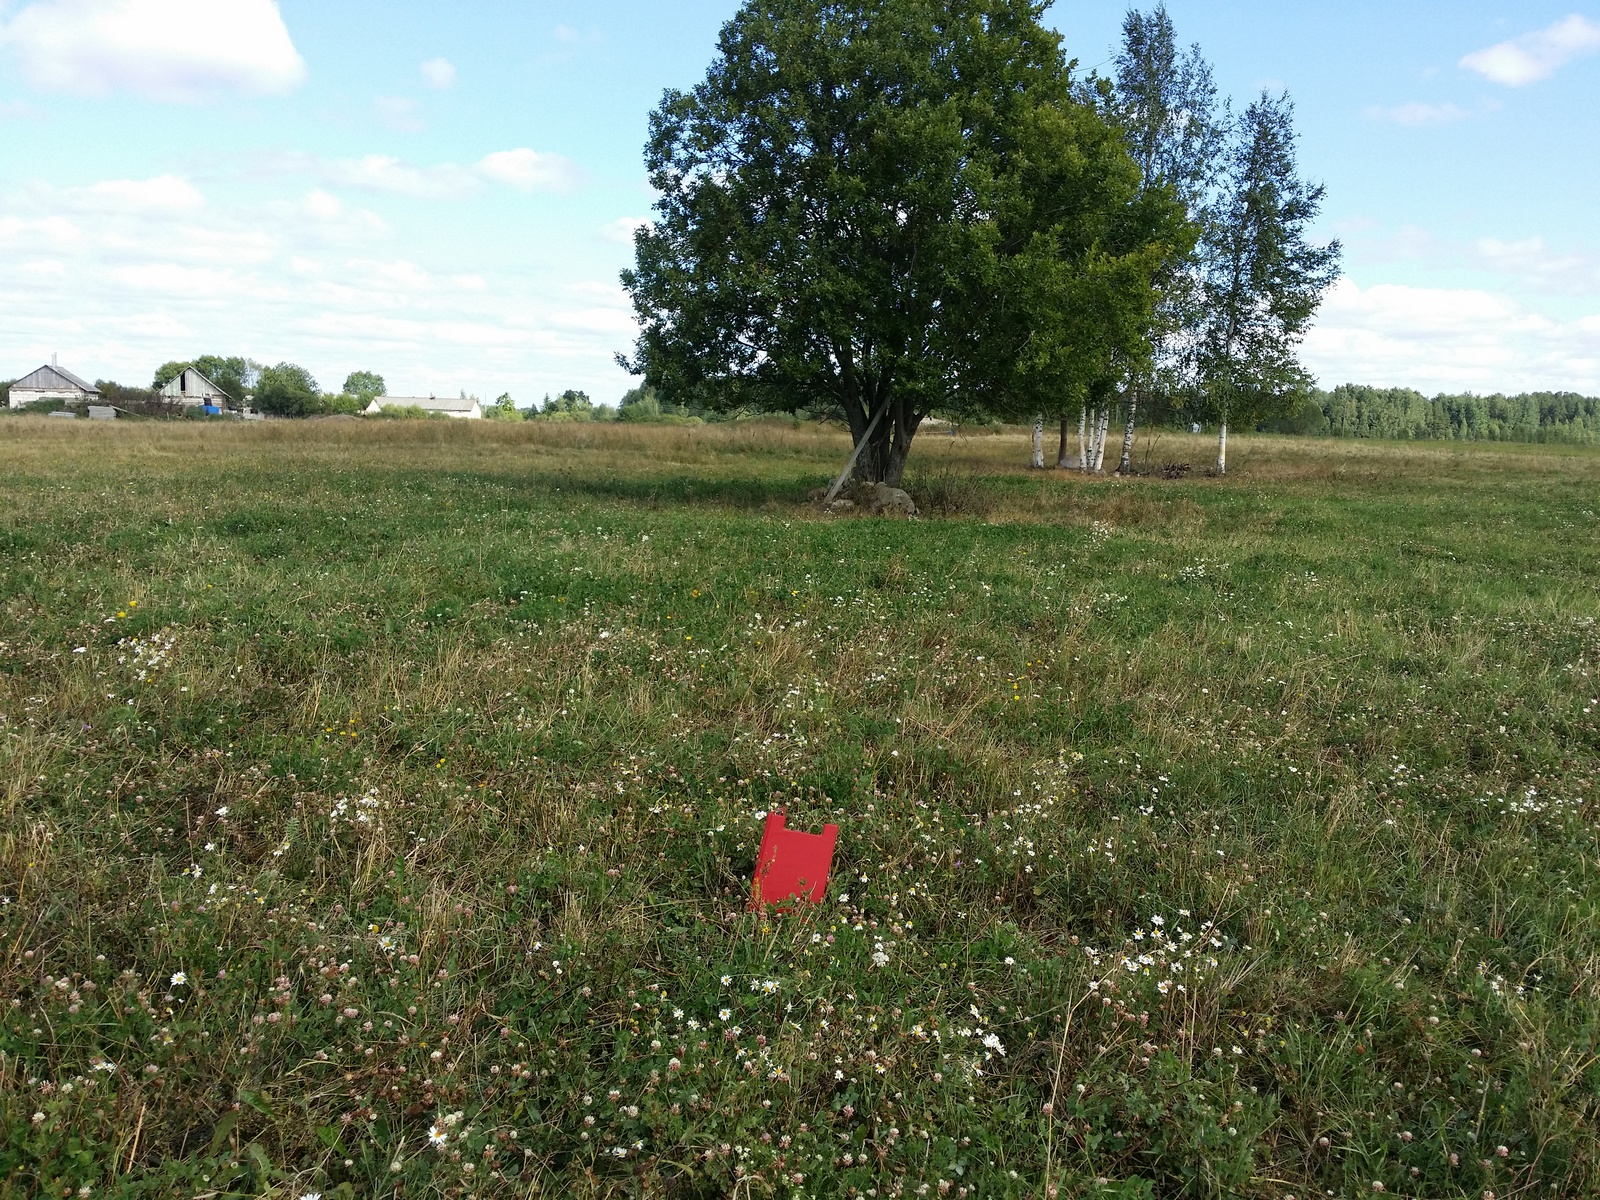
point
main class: Grassland
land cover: Grassland without tree/shrub cover
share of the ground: > 75 %
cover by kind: herbaceous plants 95 %, unconsolidated bare surface 5 %
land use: Agriculture (excluding fallow land and kitchen gardens)
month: August
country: LV
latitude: 57.2076
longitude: 27.7489
